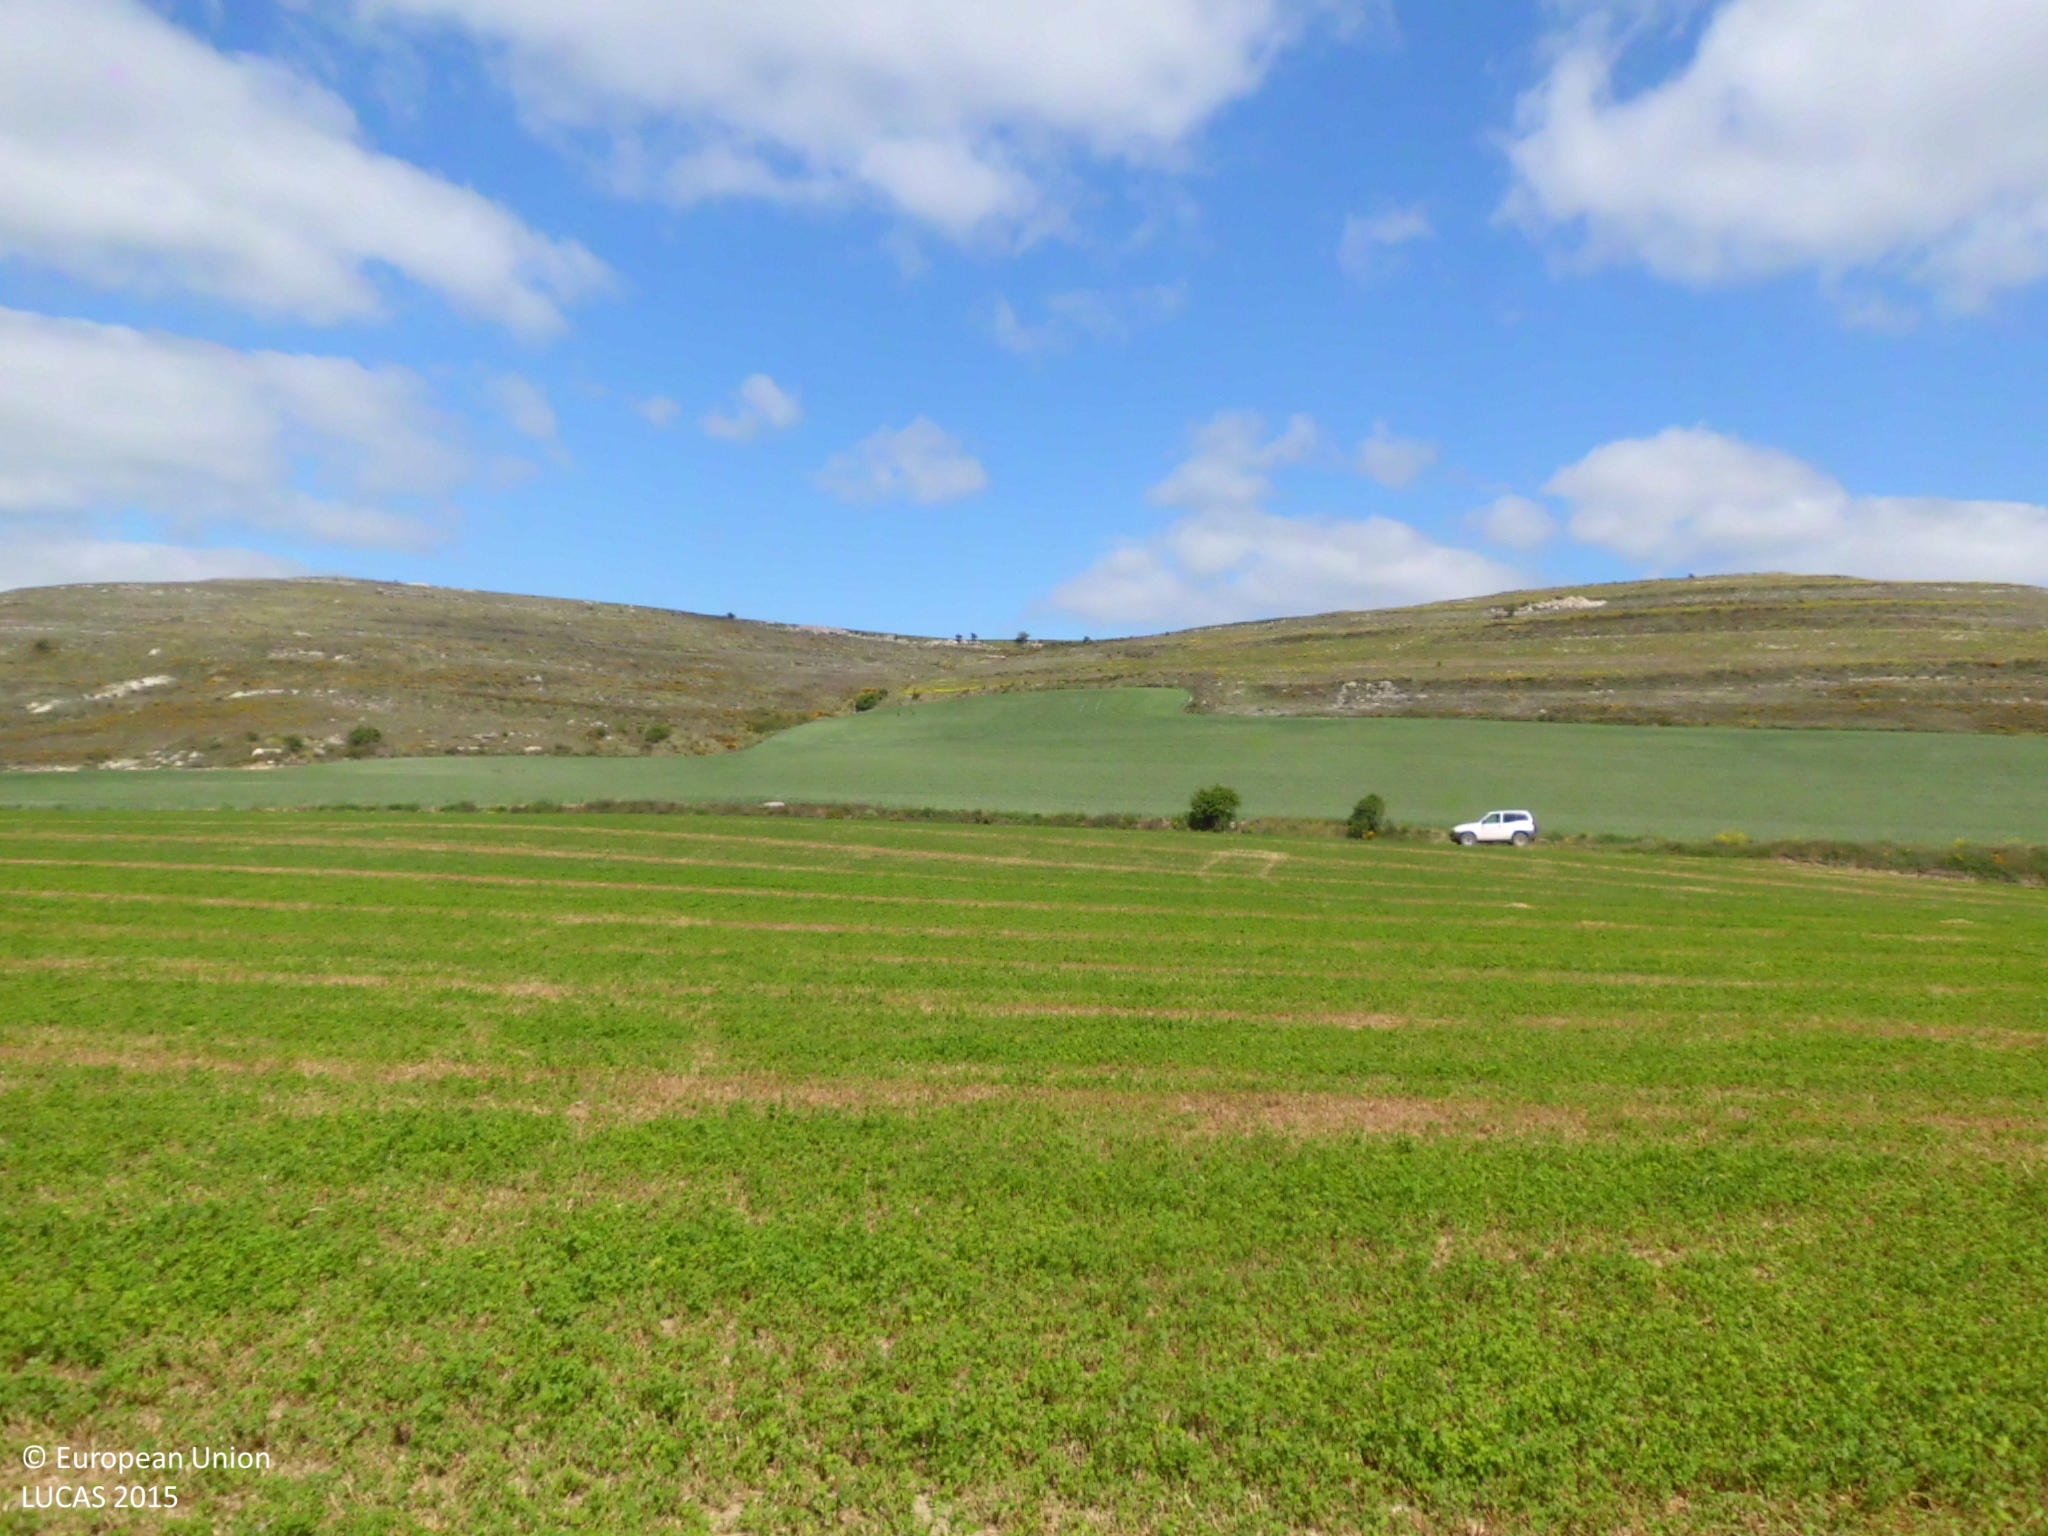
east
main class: Cropland
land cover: Lucerne
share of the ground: > 75 %
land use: Agriculture (excluding fallow land and kitchen gardens)
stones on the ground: 10 - 25 %
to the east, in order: Lucerne; Tracks; Common wheat; Grassland without tree/shrub cover
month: May
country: ES
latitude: 42.4179
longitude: -3.9311
